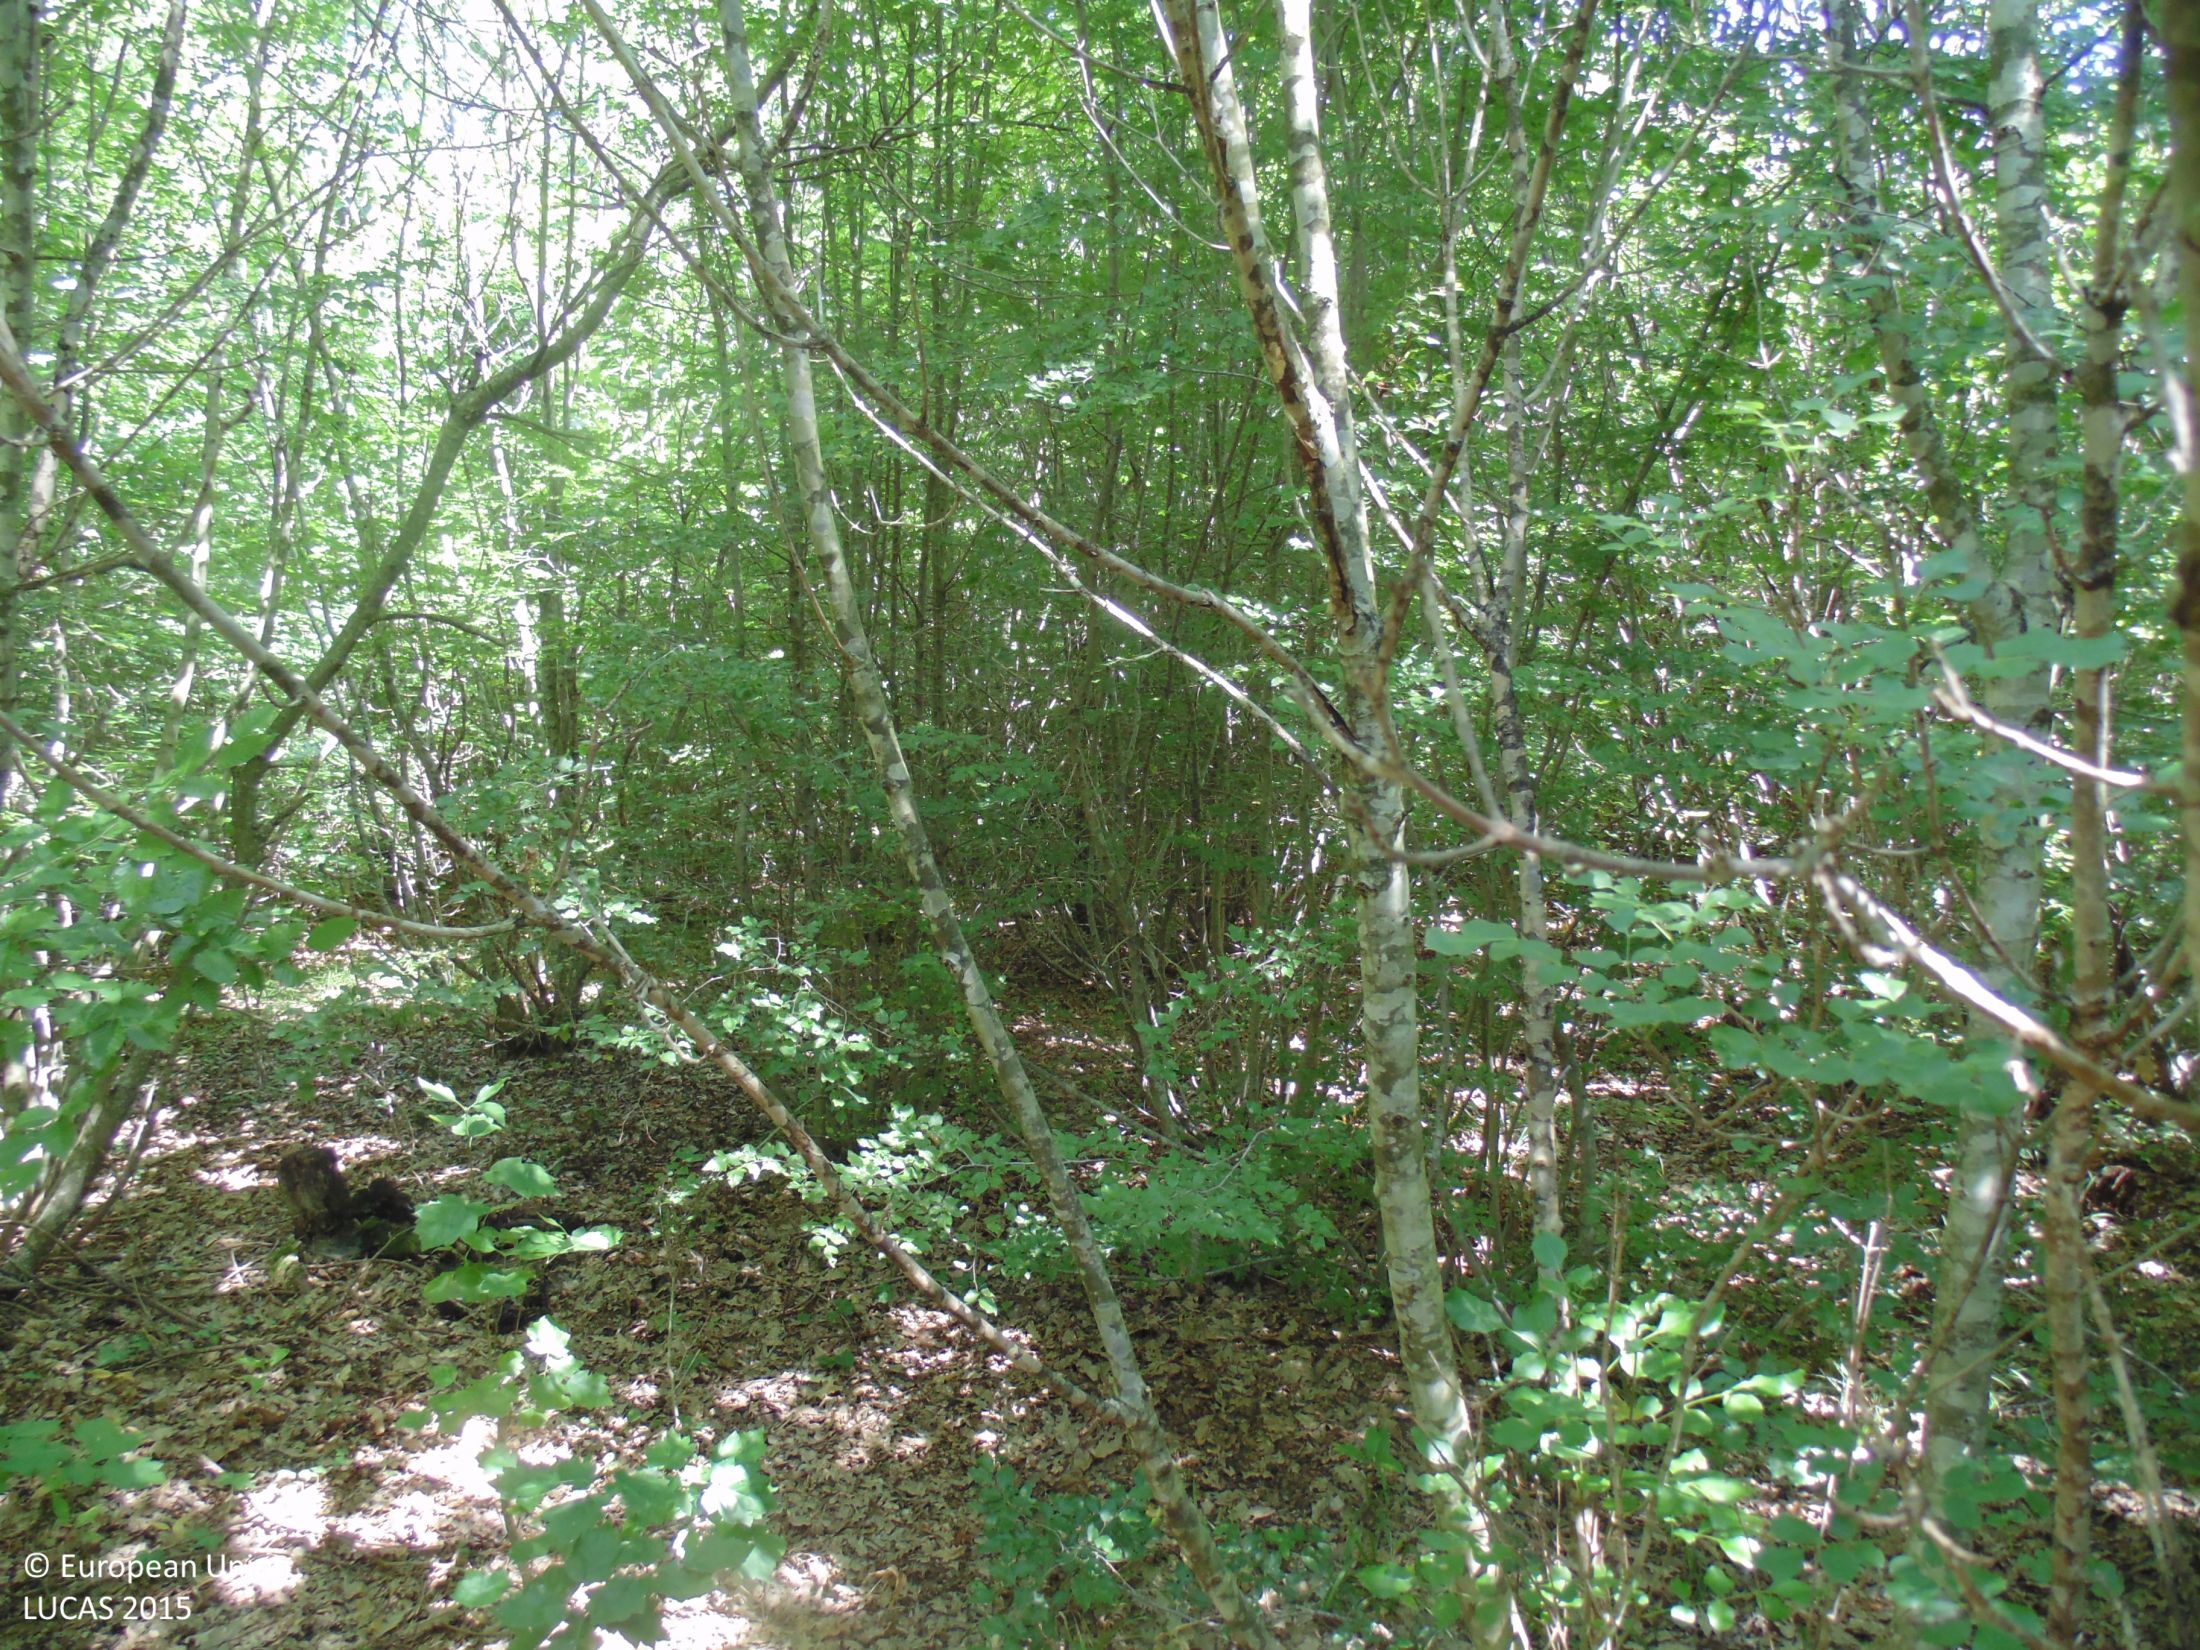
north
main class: Woodland
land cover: Broadleaved woodland
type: mesophytic deciduous forest
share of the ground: > 75 %
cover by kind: broadleaved forest trees 85 %, shrubs 10 %, unconsolidated bare surface 5 %
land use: Forestry
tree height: > 5 m
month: July
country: BG
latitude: 43.3862
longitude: 27.9047
